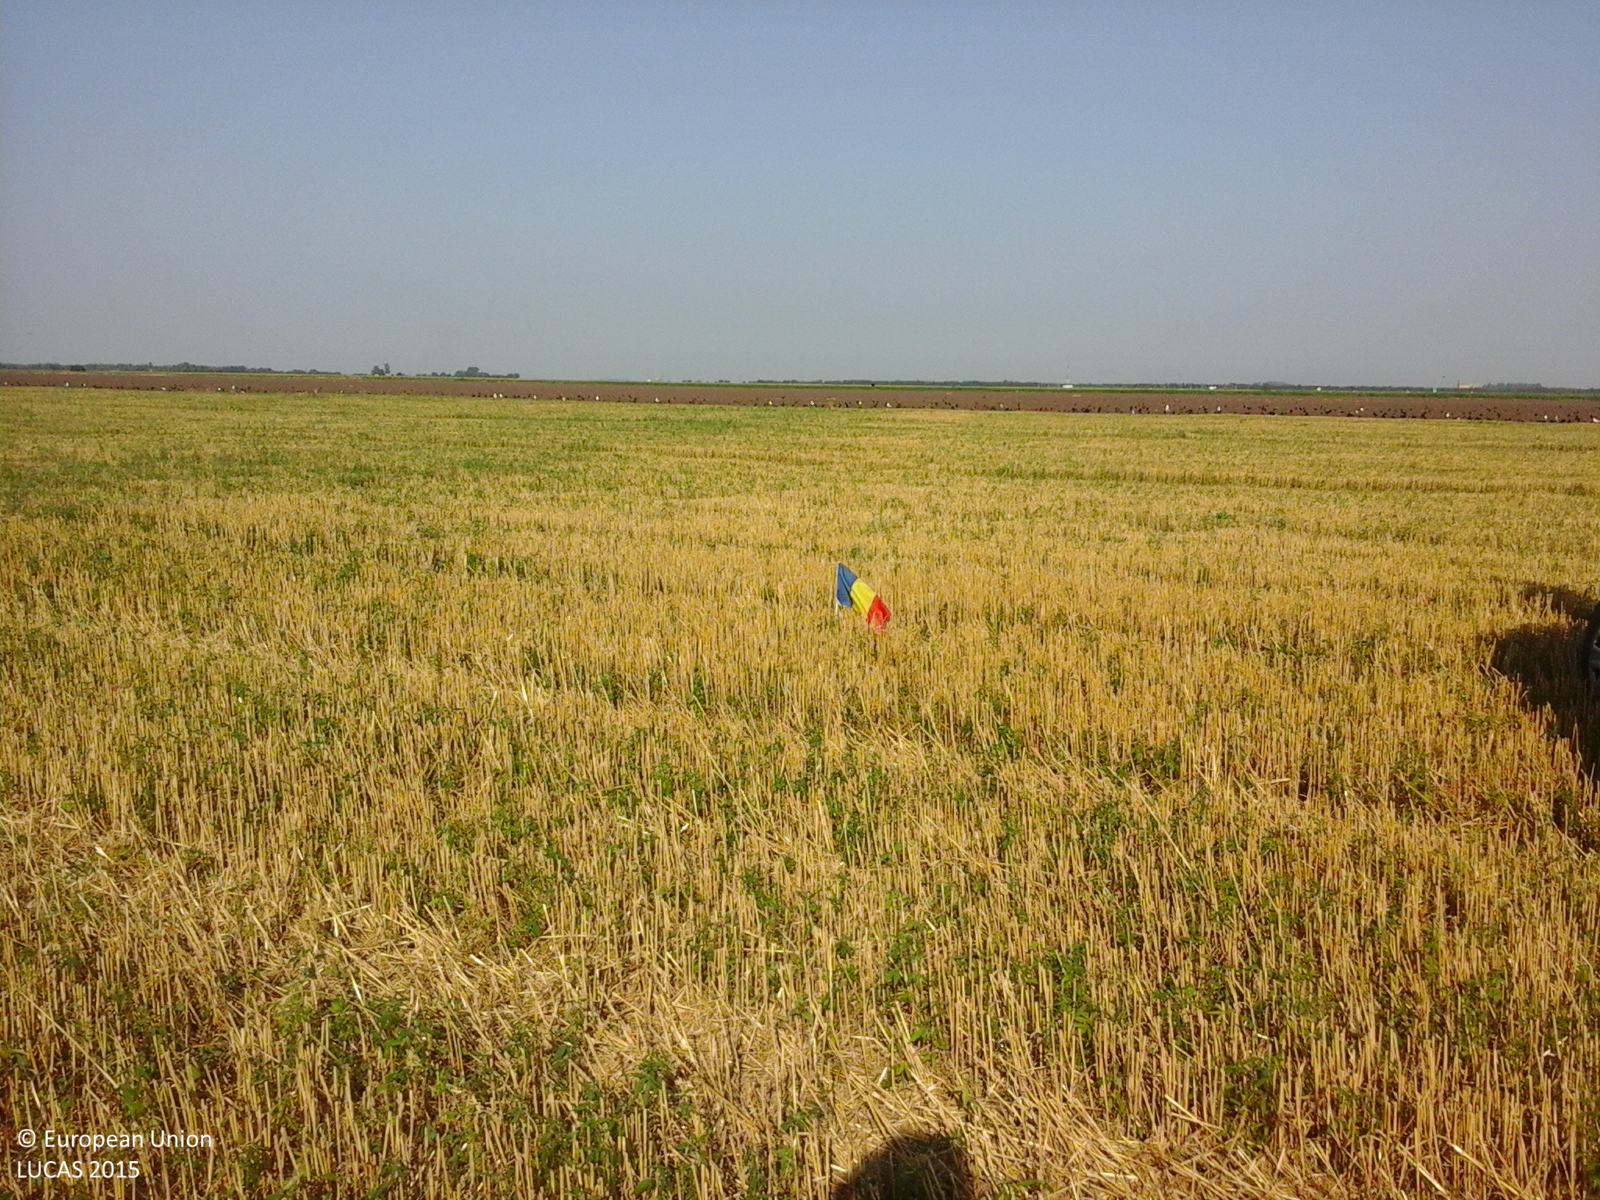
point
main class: Cropland
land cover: Common wheat
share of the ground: > 75 %
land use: Agriculture (excluding fallow land and kitchen gardens)
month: July
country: RO
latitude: 44.4220
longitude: 27.0221
